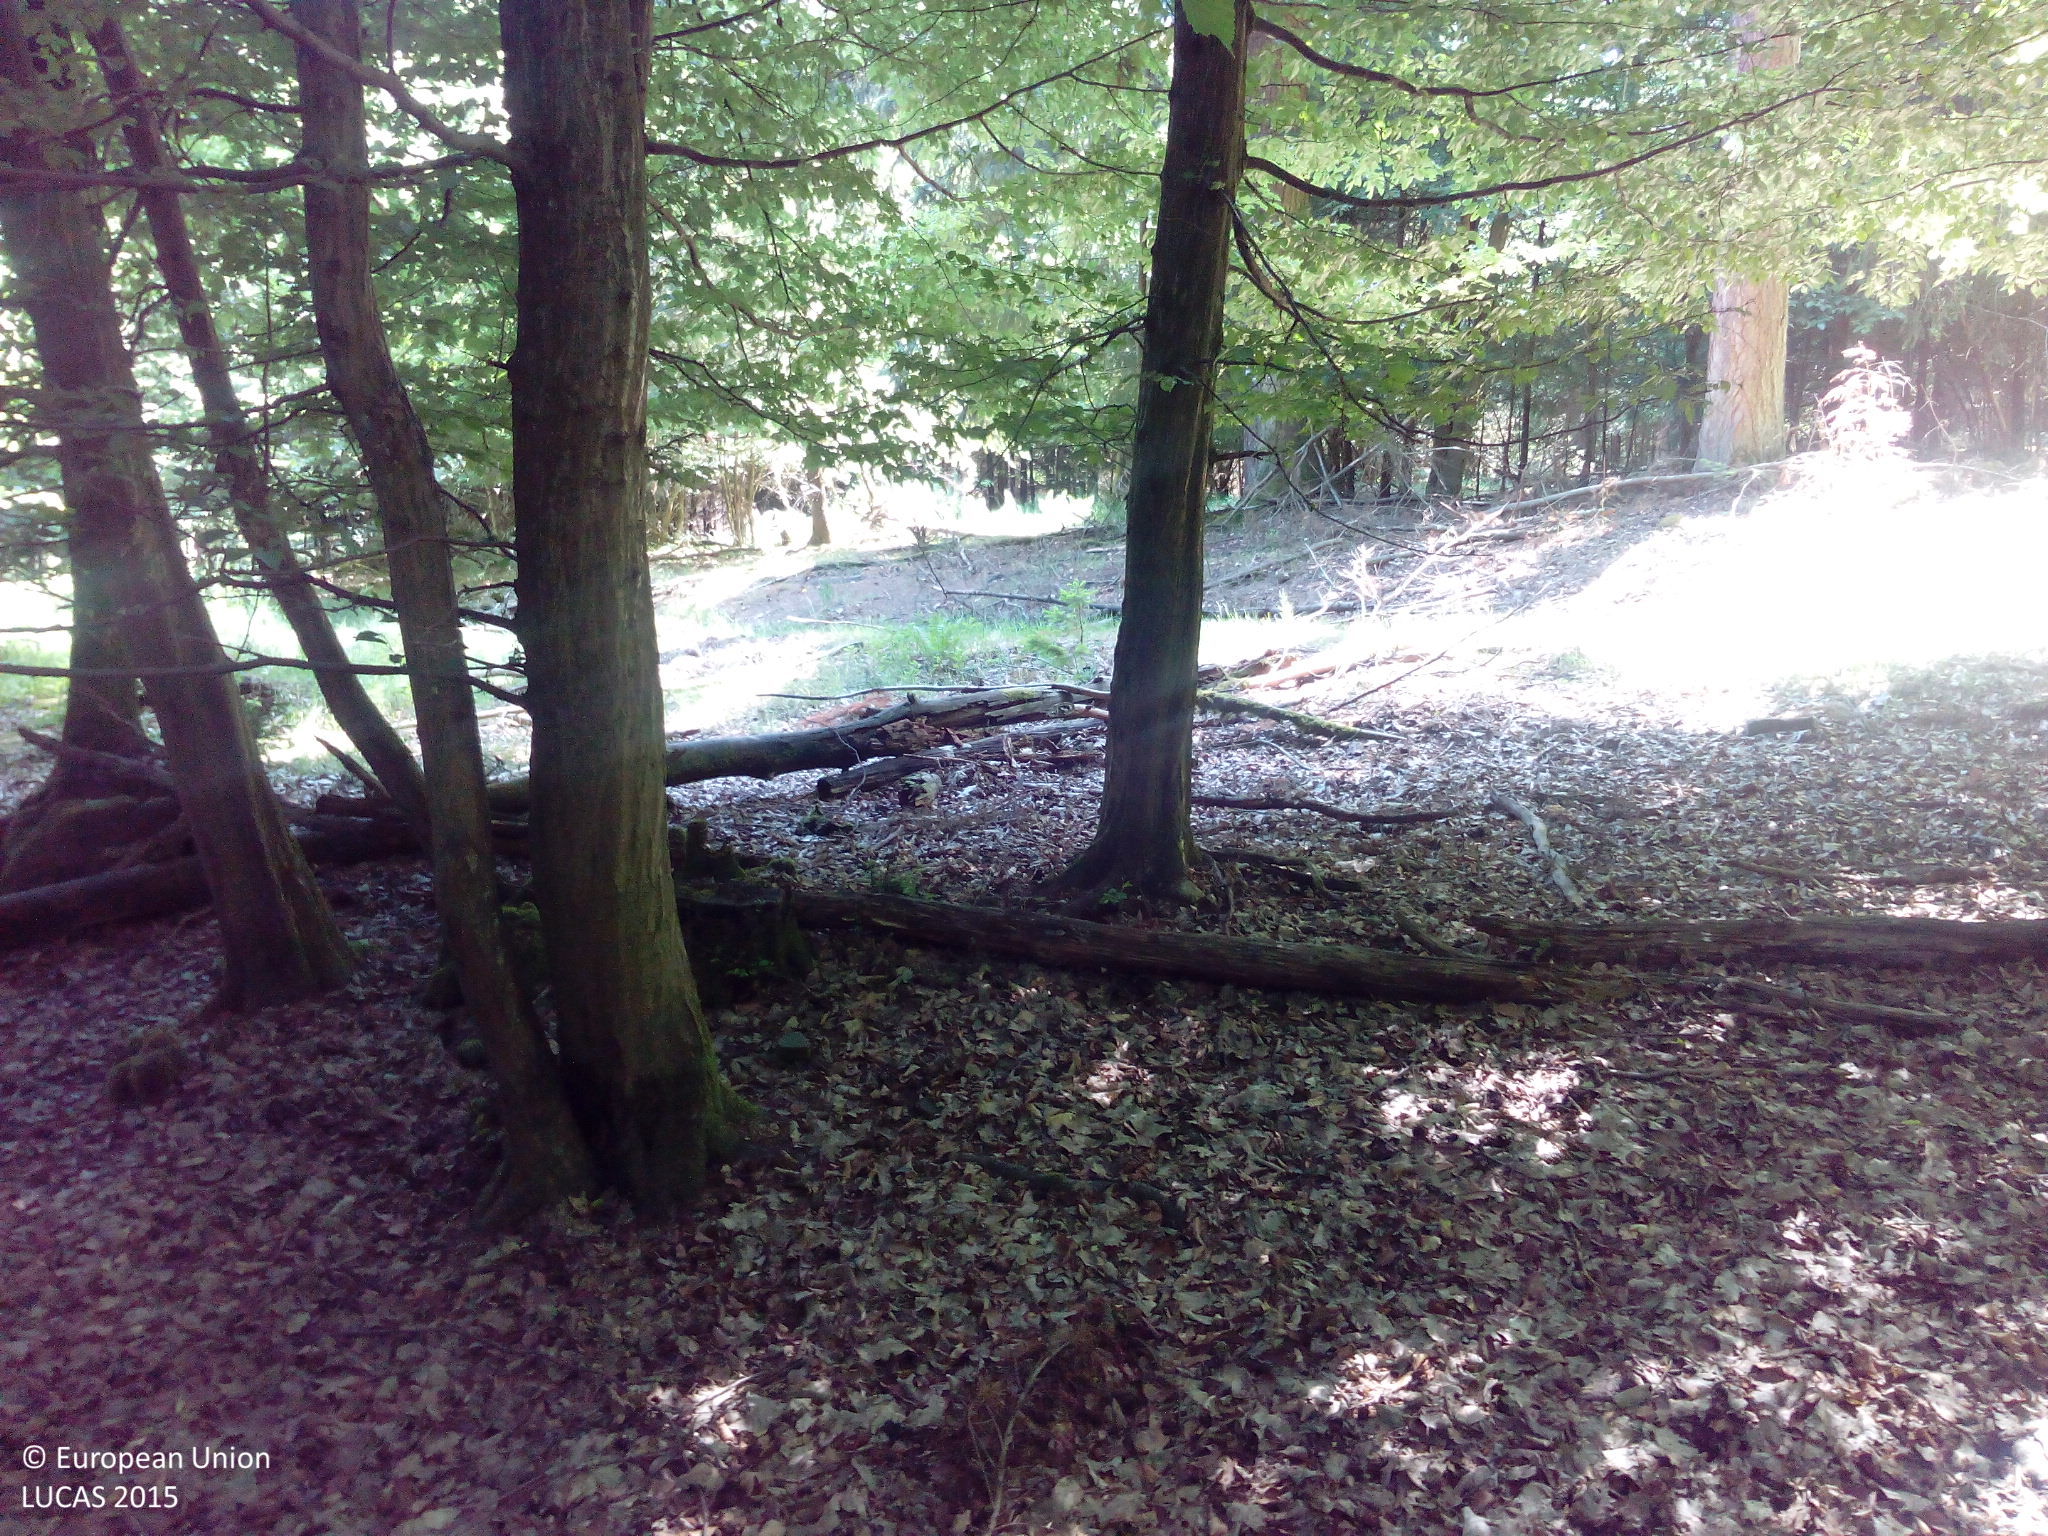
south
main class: Woodland
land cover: Broadleaved woodland
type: mesophytic deciduous forest
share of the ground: > 75 %
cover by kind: broadleaved forest trees 90 %, unconsolidated bare surface 10 %
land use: Forestry
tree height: > 5 m
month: June
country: DE
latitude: 50.1851
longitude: 8.0257
